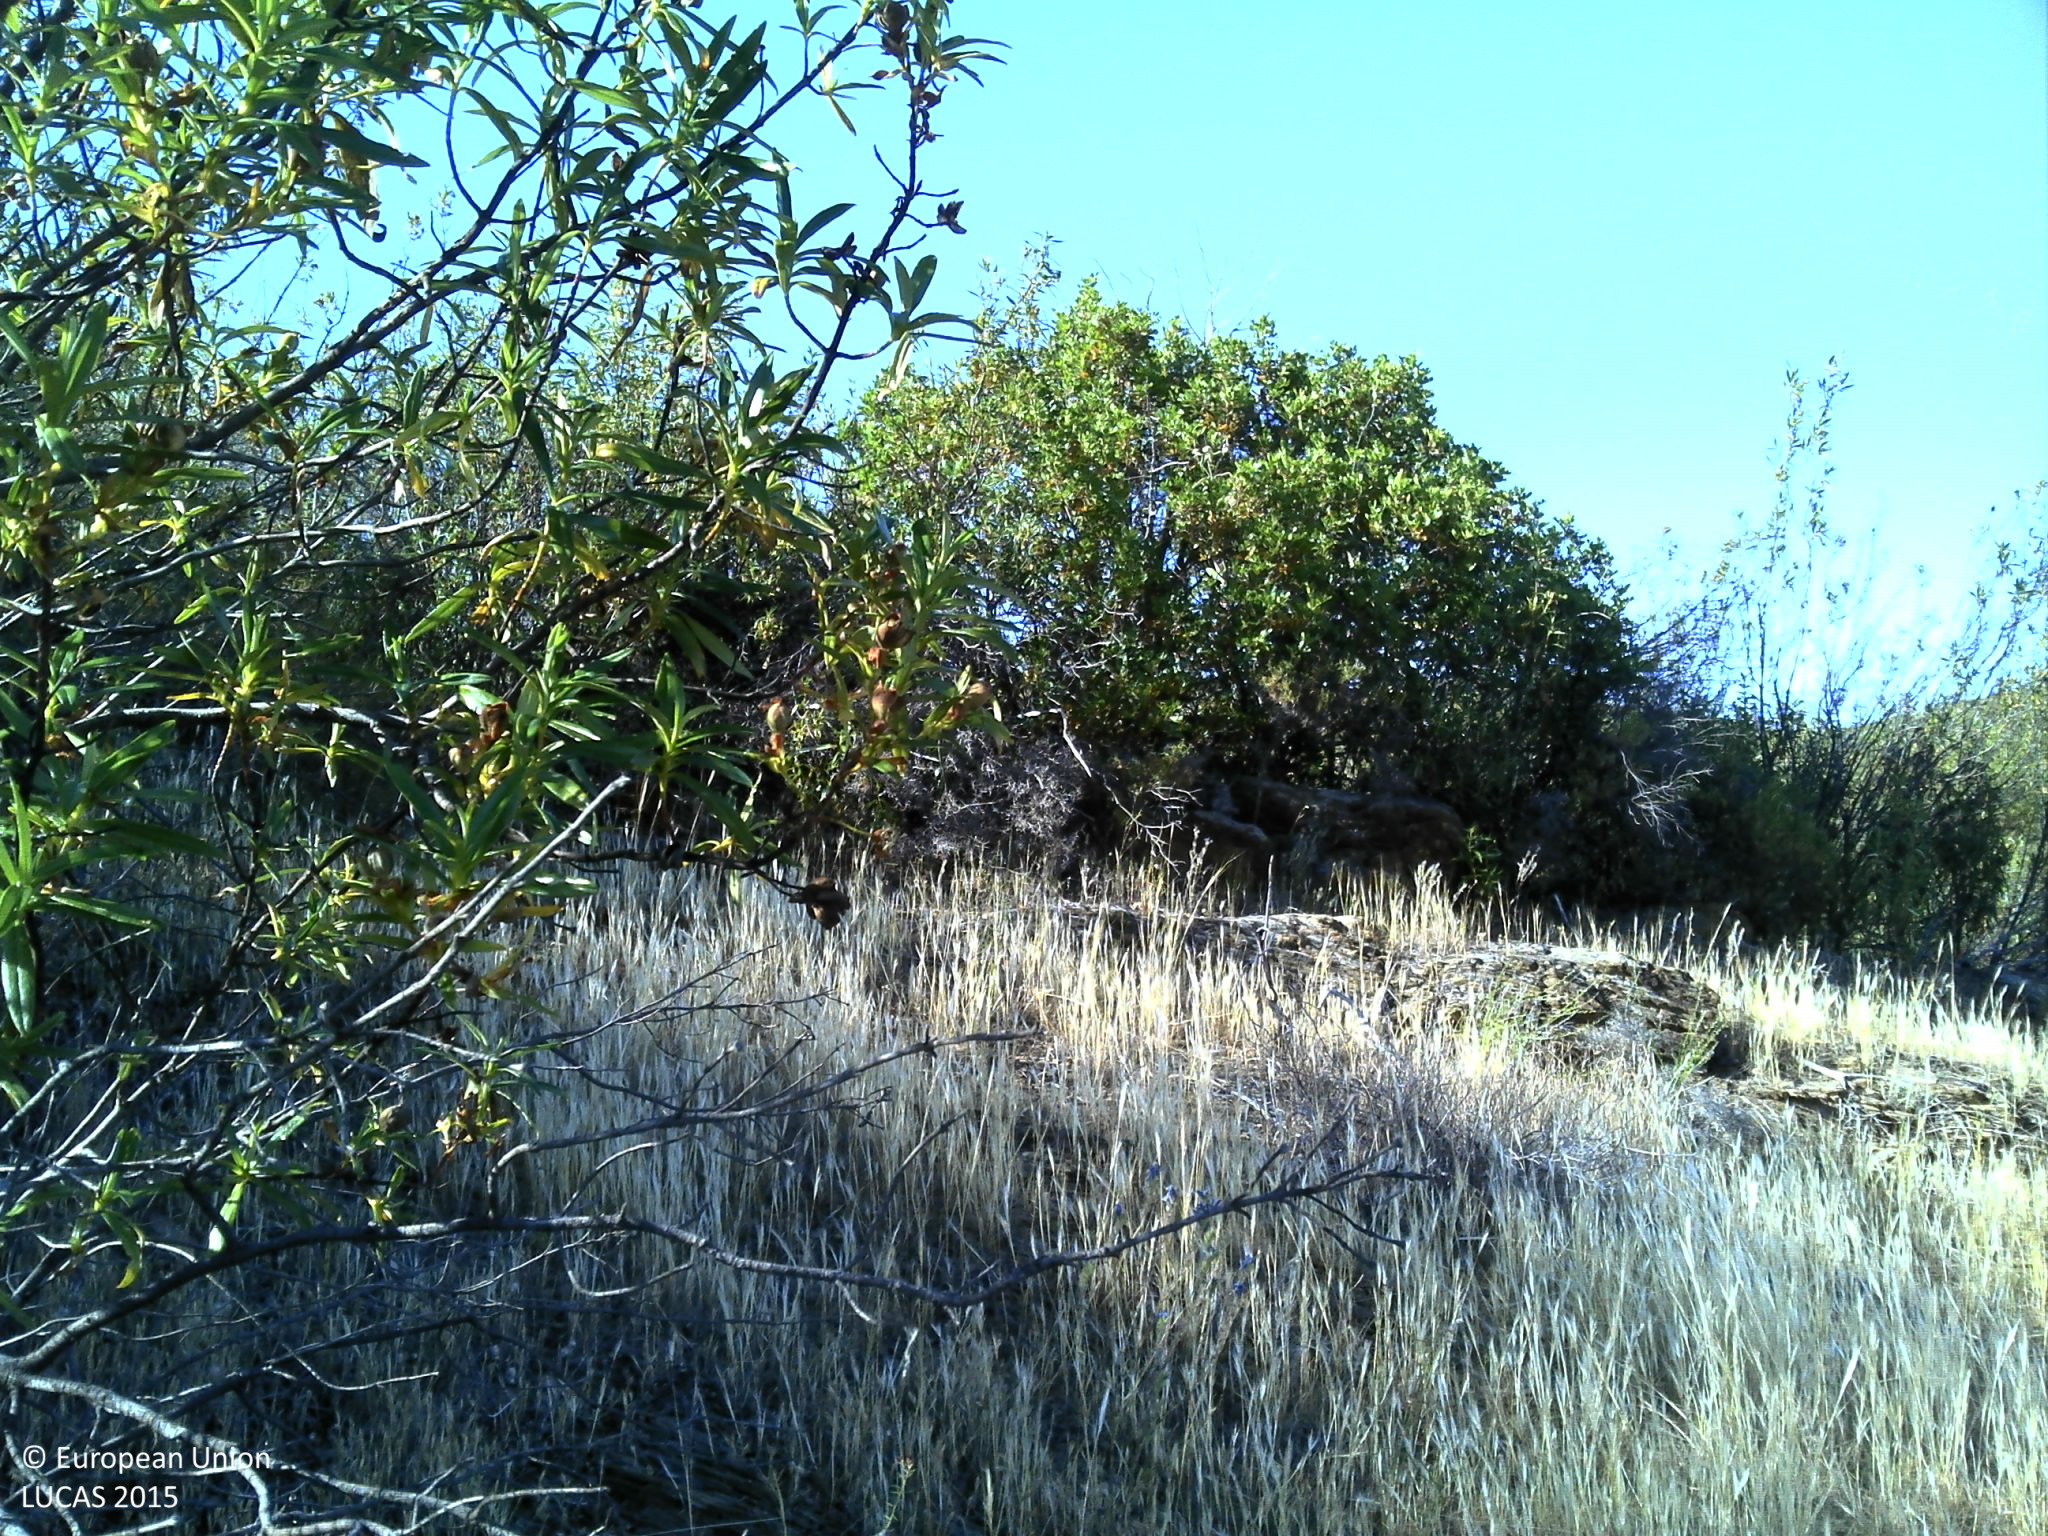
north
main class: Shrubland
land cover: Shrubland without tree cover
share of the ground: > 75 %
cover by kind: shrubs 95 %, unconsolidated bare surface 5 %
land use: Semi-natural and natural areas not in use
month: May
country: PT
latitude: 37.5237
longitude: -7.5608
